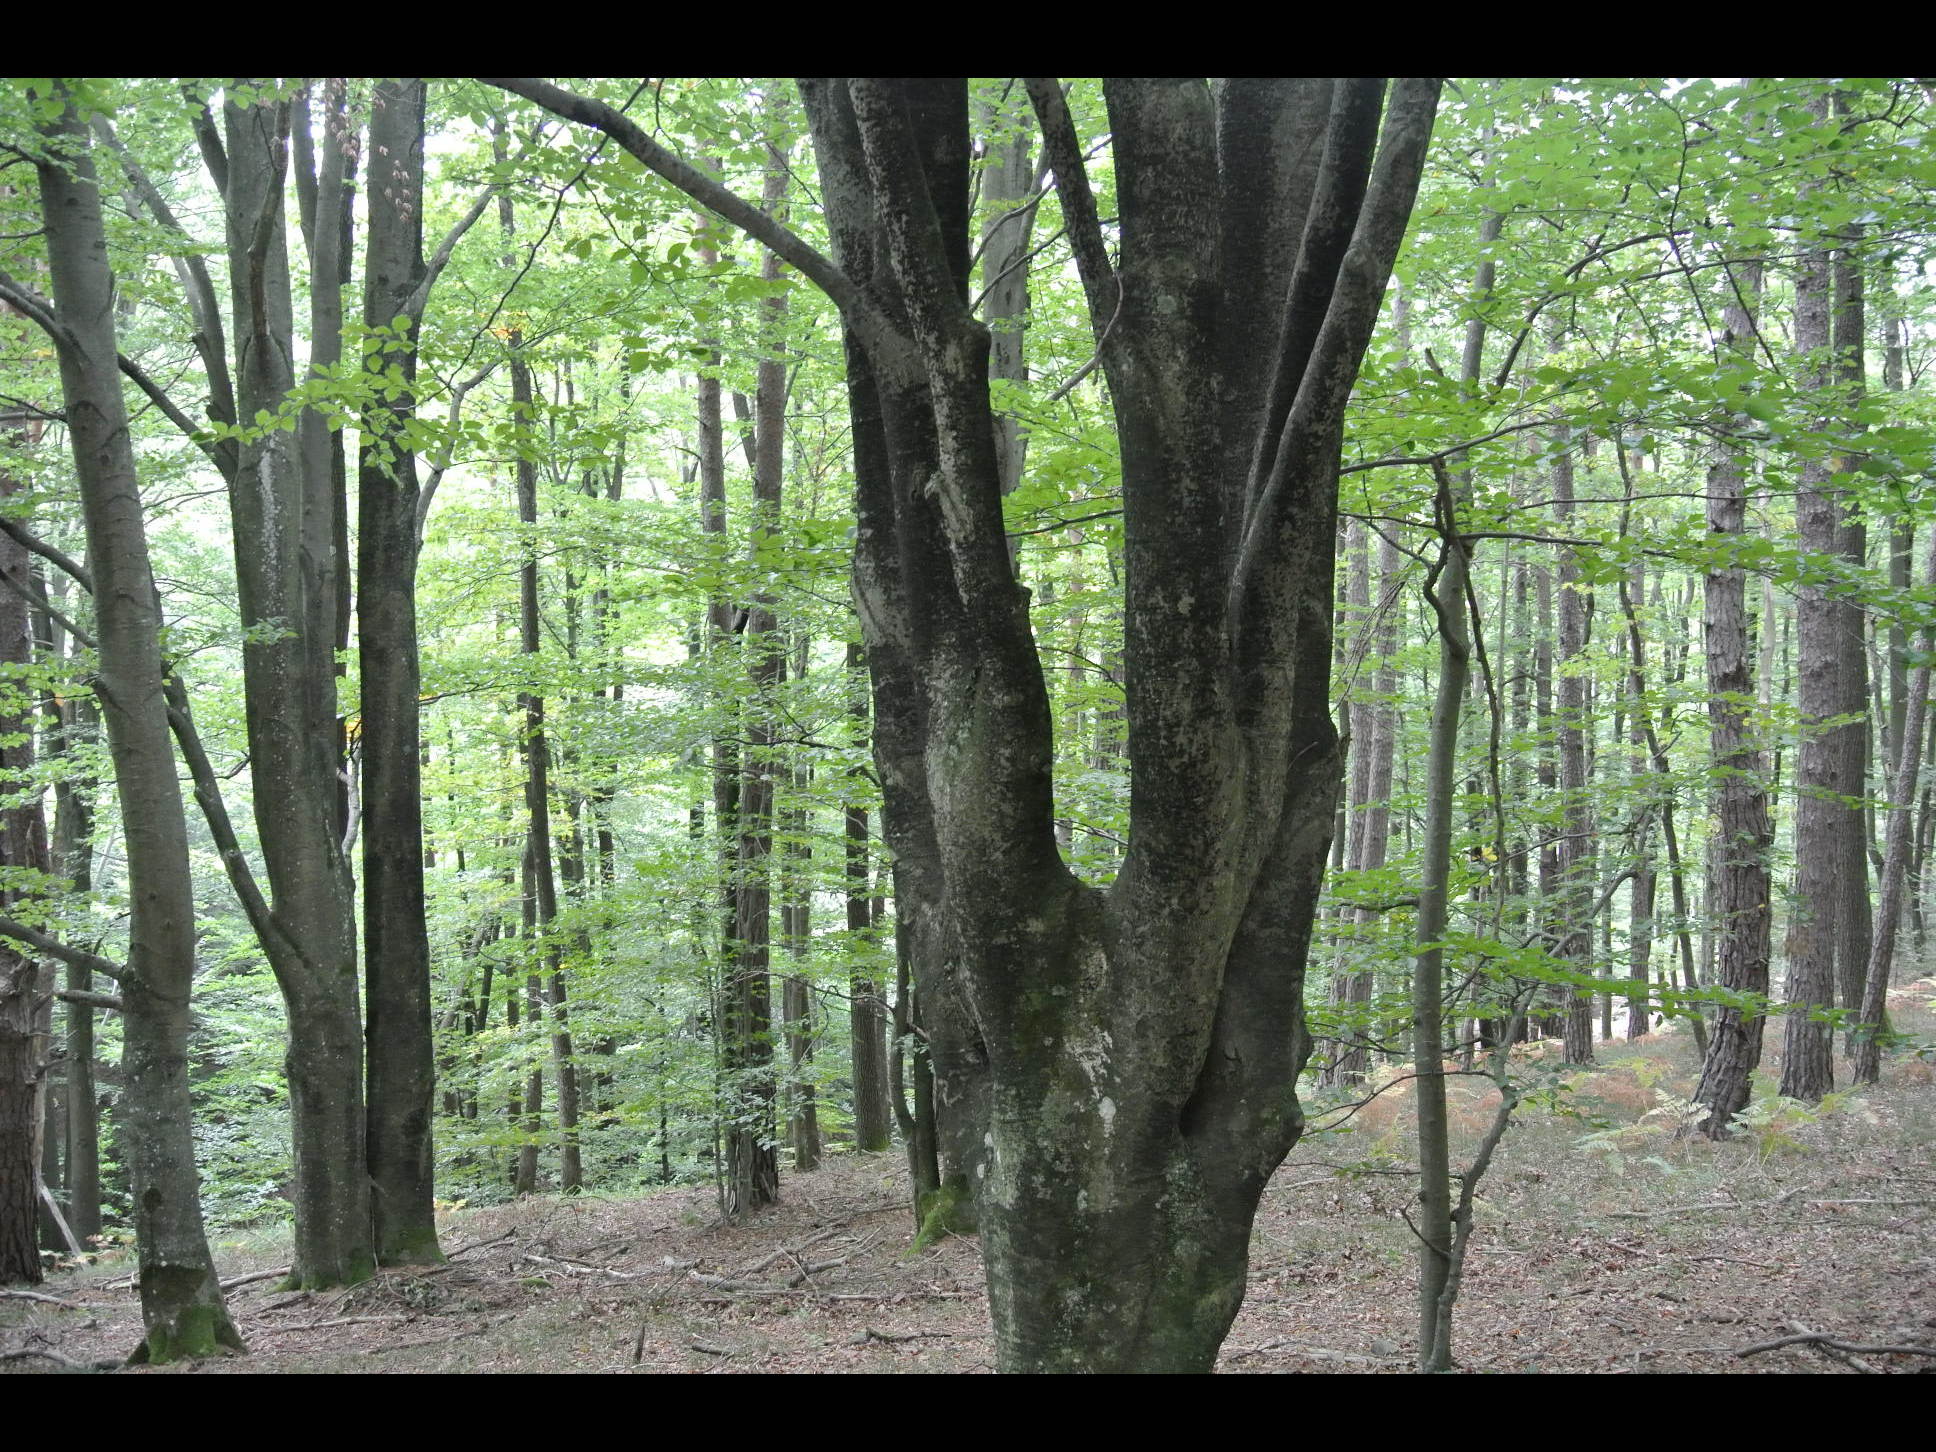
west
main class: Woodland
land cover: Pine dominated mixed woodland
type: alpine coniferous forest
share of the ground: > 75 %
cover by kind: coniferous forest trees 50 %, broadleaved forest trees 50 %
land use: Forestry
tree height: > 5 m
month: September
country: AT
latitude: 47.3876
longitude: 16.4015
